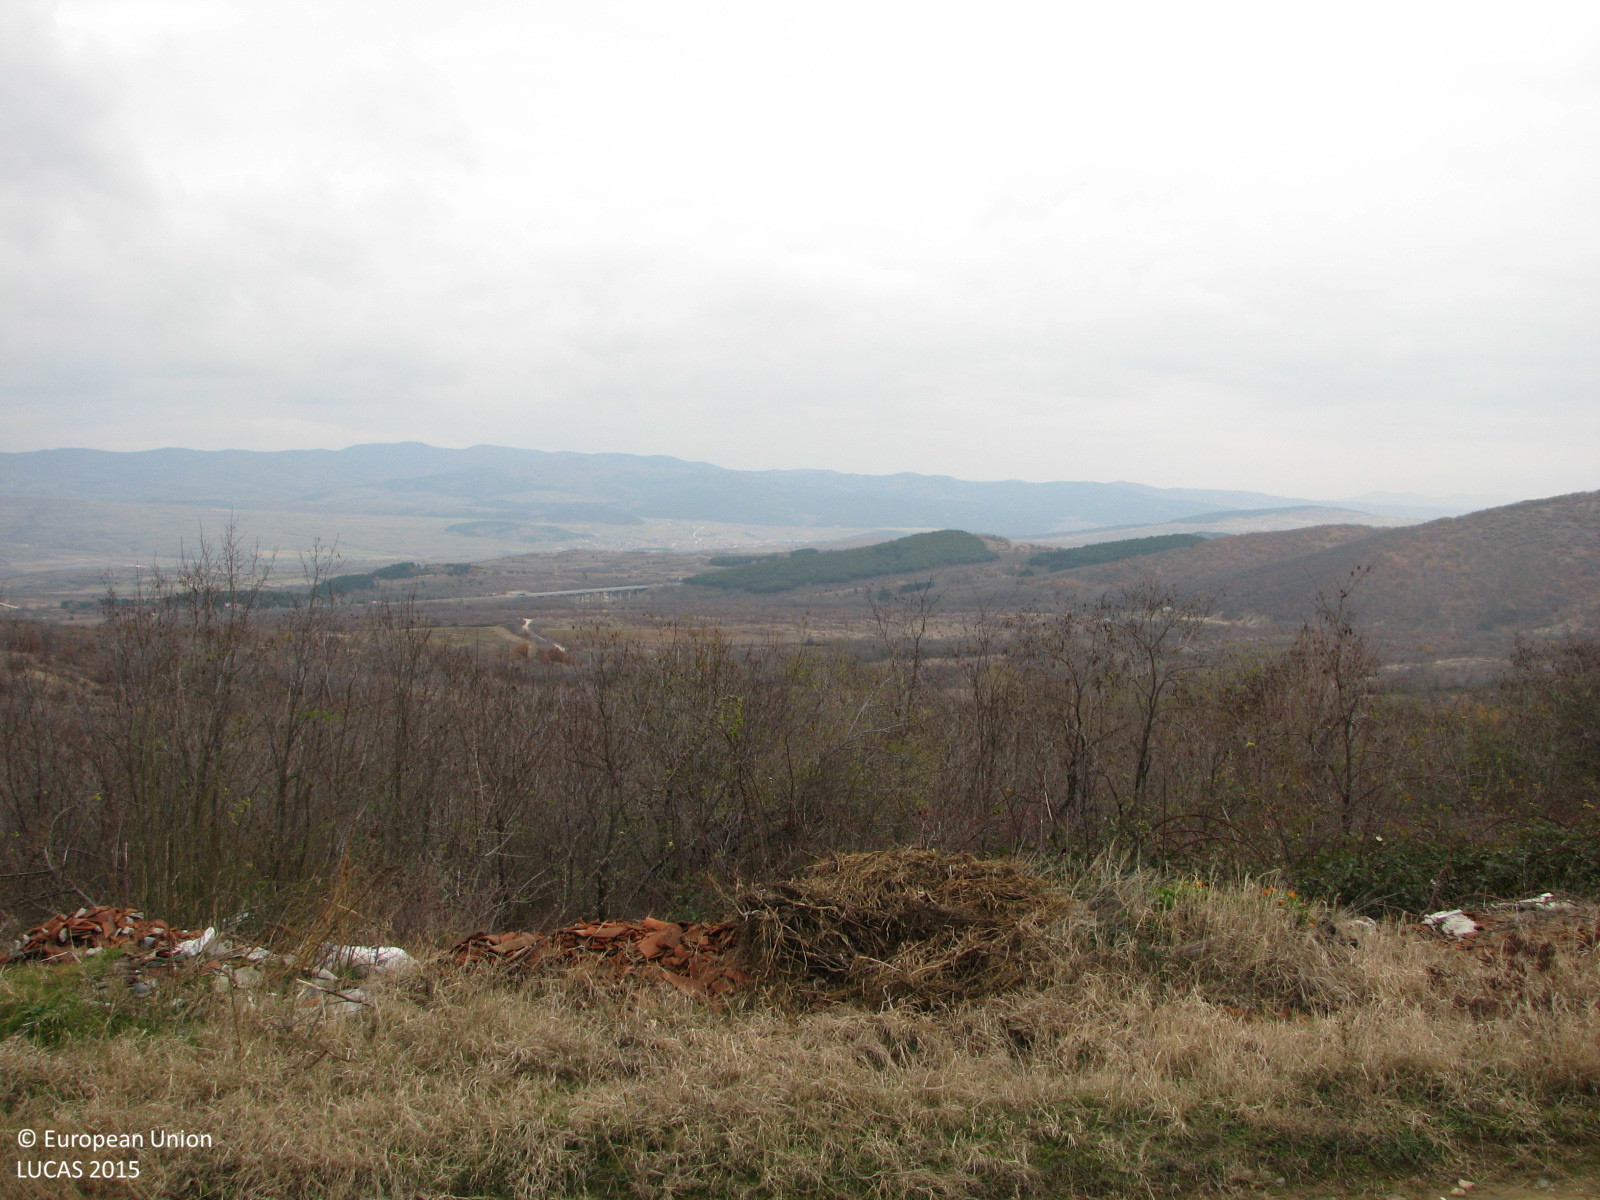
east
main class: Grassland
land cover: Grassland with sparse tree/shrub cover
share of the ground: > 75 %
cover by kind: herbaceous plants 80 %, broadleaved forest trees 5 %, shrubs 5 %, lichens and mosses 5 %, unconsolidated bare surface 5 %
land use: Semi-natural and natural areas not in use
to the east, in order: Grassland with sparse tree/shrub cover; Broadleaved woodland; Grassland with sparse tree/shrub cover; Broadleaved woodland; Grassland with sparse tree/shrub cover; Broadleaved woodland
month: December
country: BG
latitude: 42.3304
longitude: 24.0339
